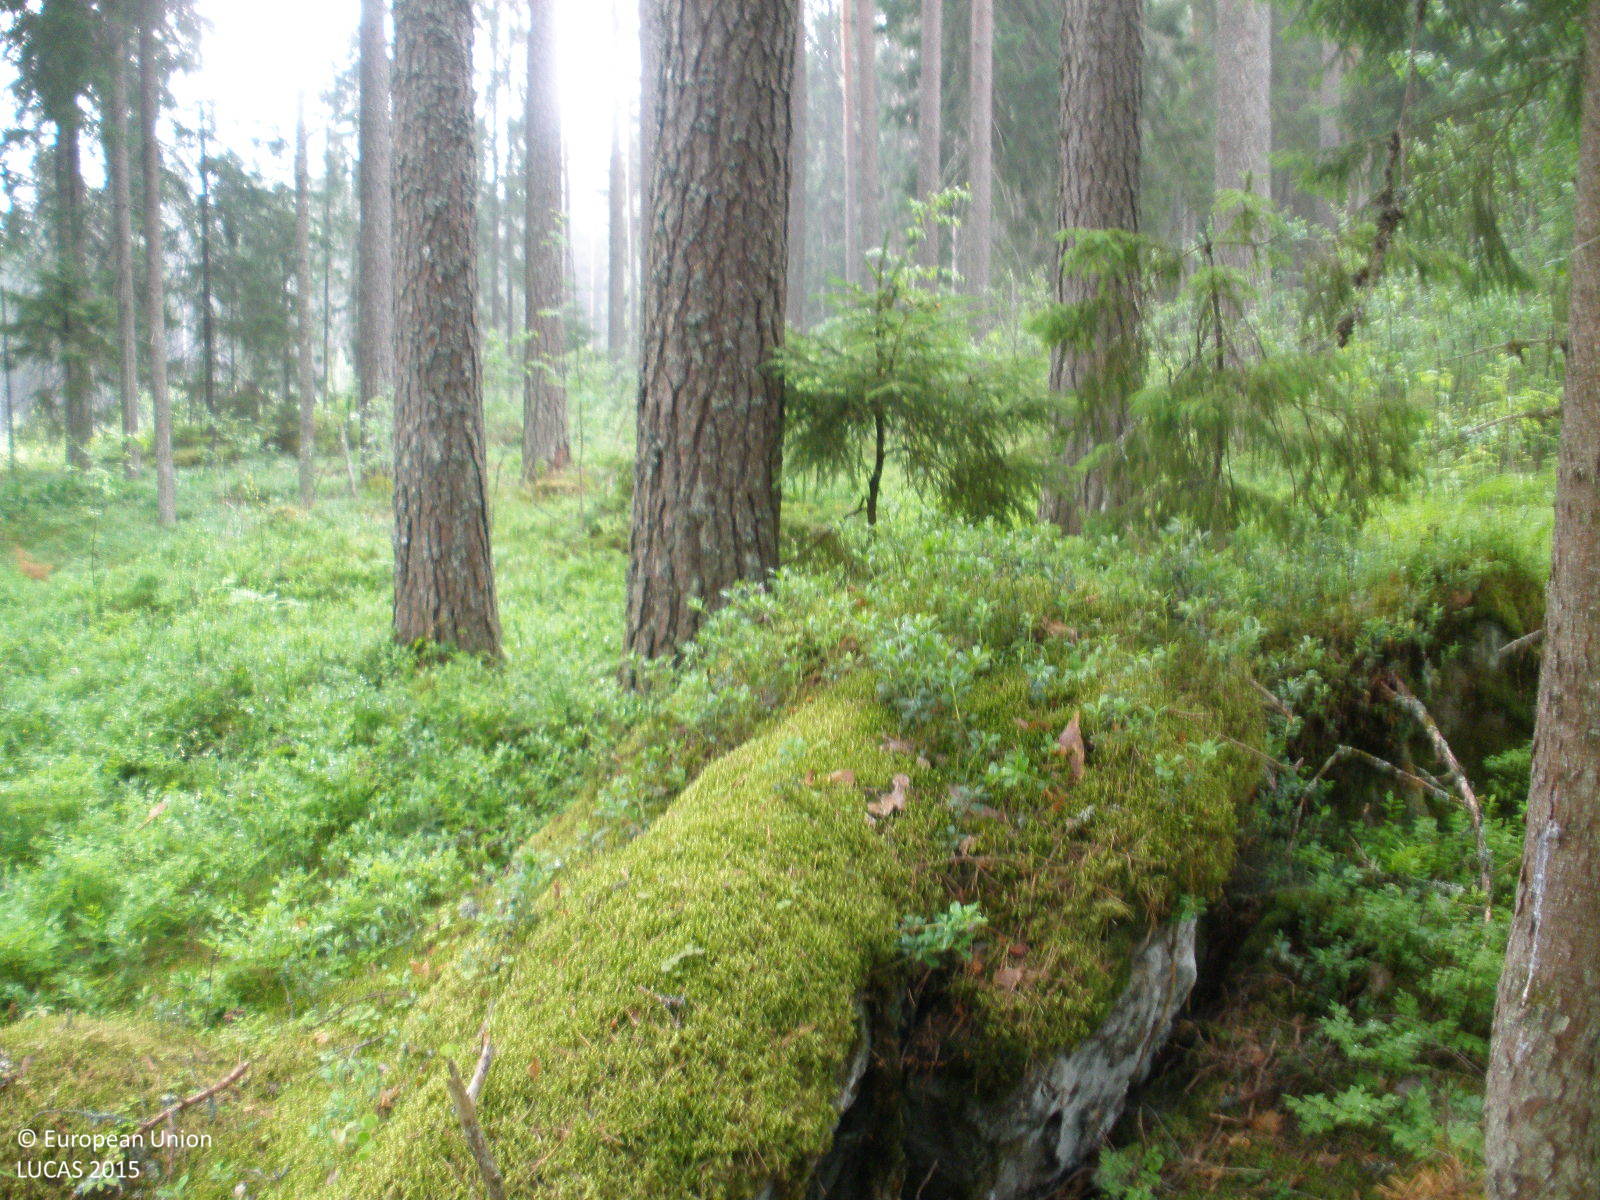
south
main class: Woodland
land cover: Pine dominated coniferous woodland
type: boreal forest
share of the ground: > 75 %
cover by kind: coniferous forest trees 75 %, shrubs 10 %, lichens and mosses 10 %, herbaceous plants 5 %
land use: Forestry
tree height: > 5 m
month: July
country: FI
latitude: 61.3659
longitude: 24.5609
